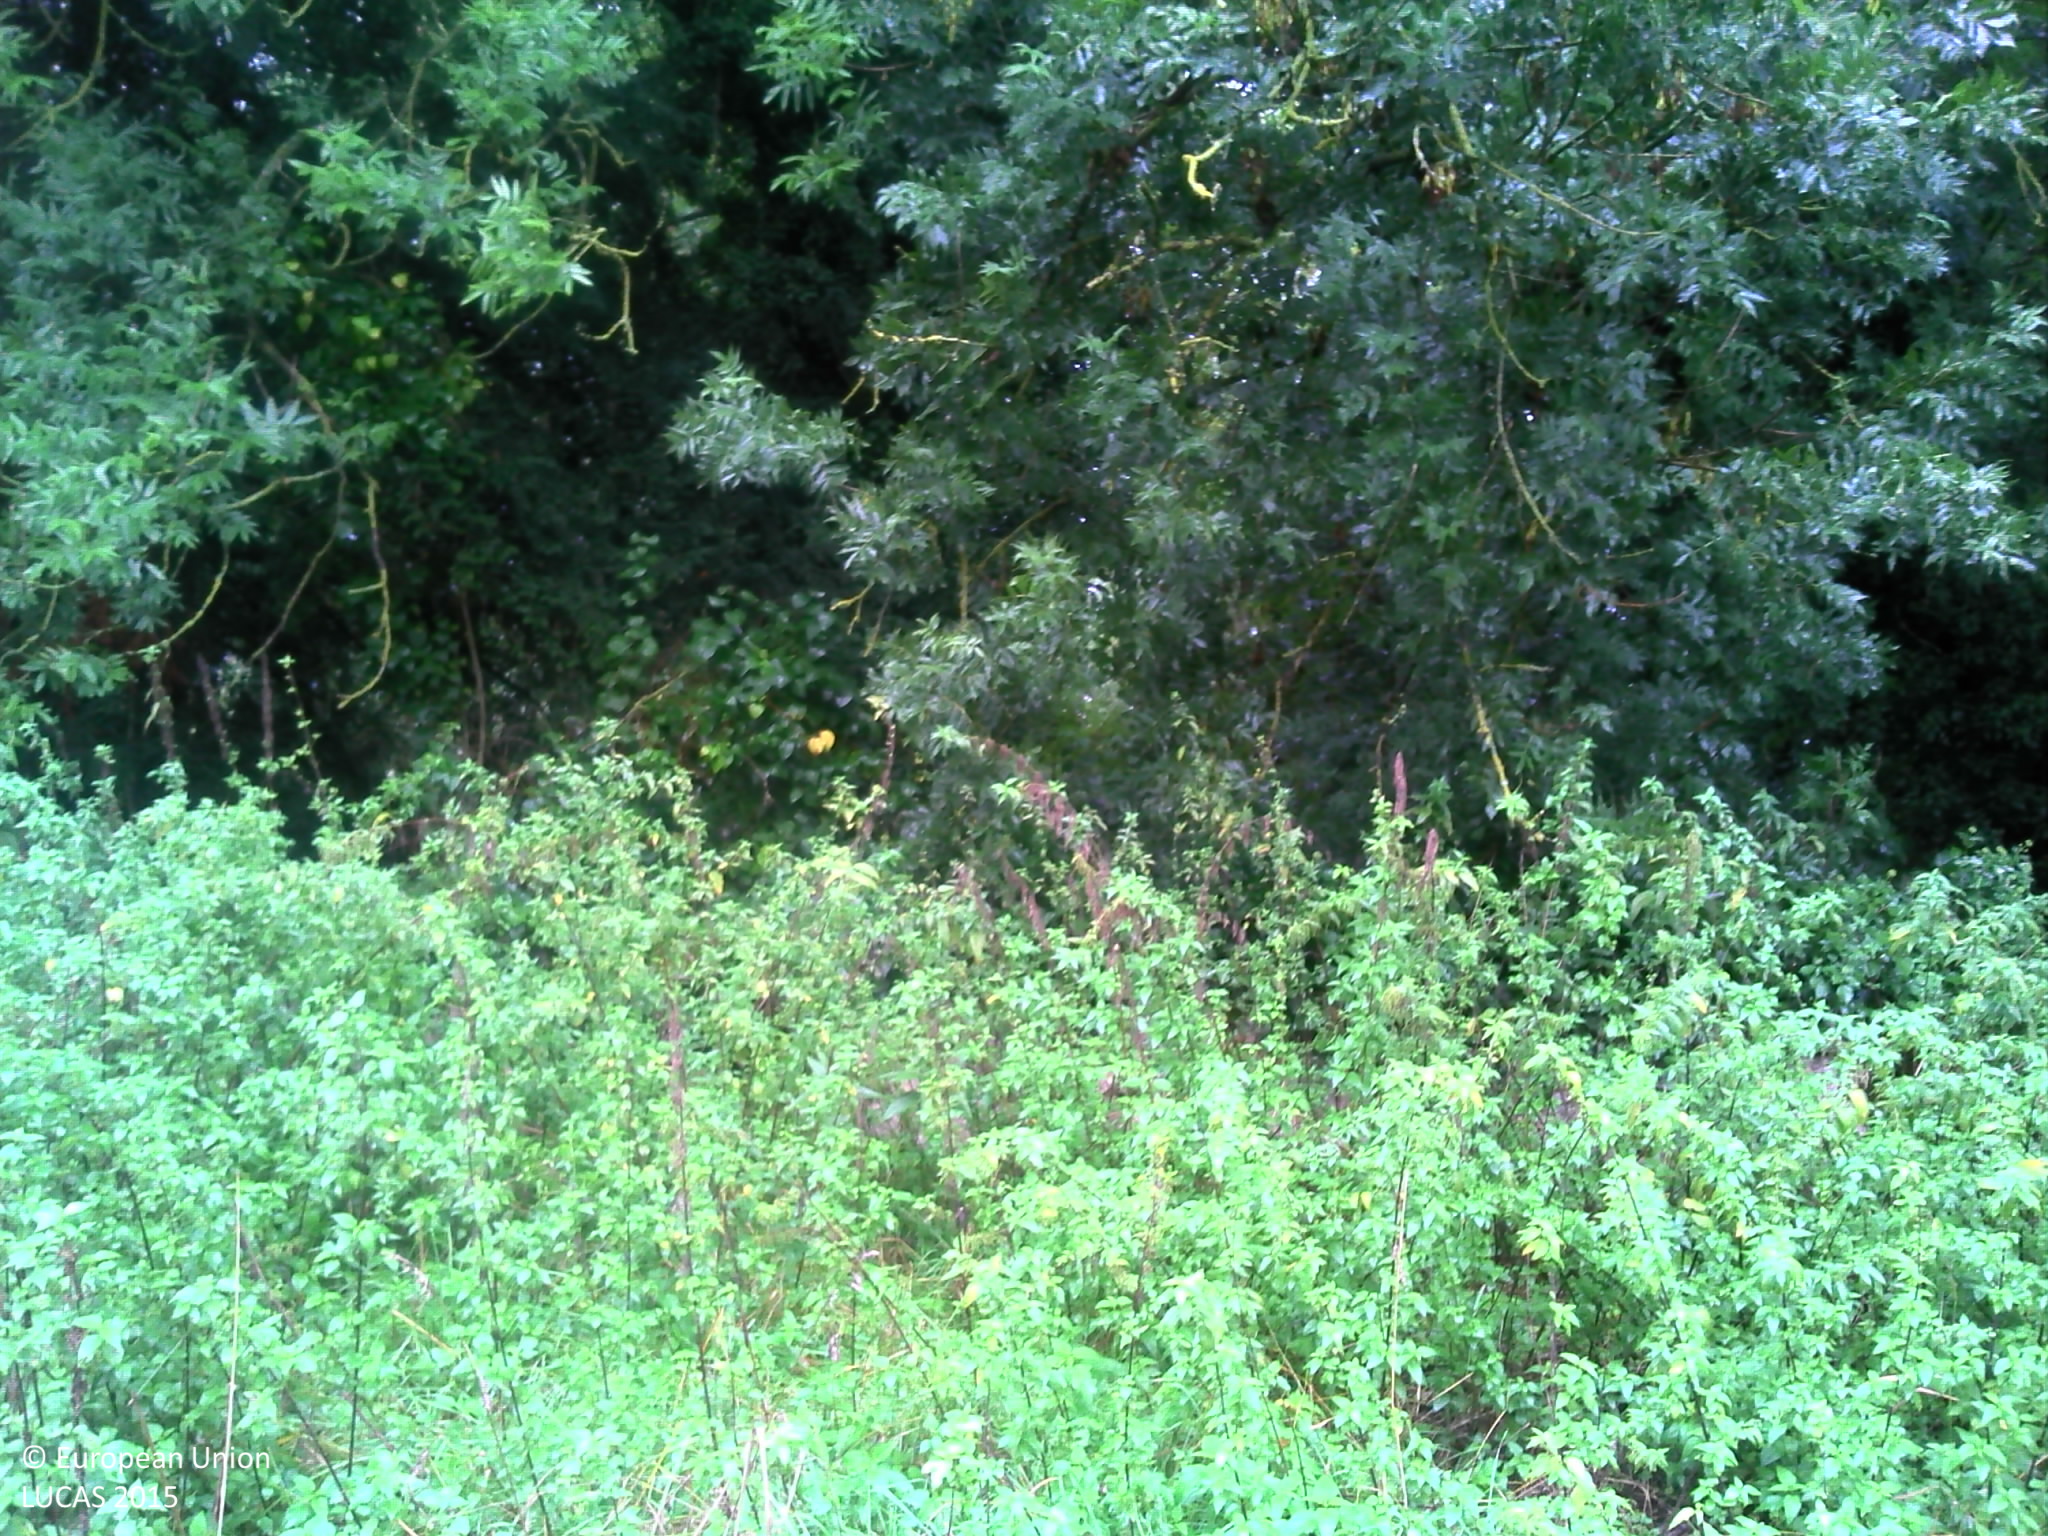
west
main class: Grassland
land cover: Grassland with sparse tree/shrub cover
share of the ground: > 75 %
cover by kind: herbaceous plants 85 %, consolidated bare surface 10 %, broadleaved forest trees 5 %
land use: Community services
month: September
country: FR
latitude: 48.7338
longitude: 6.1794
